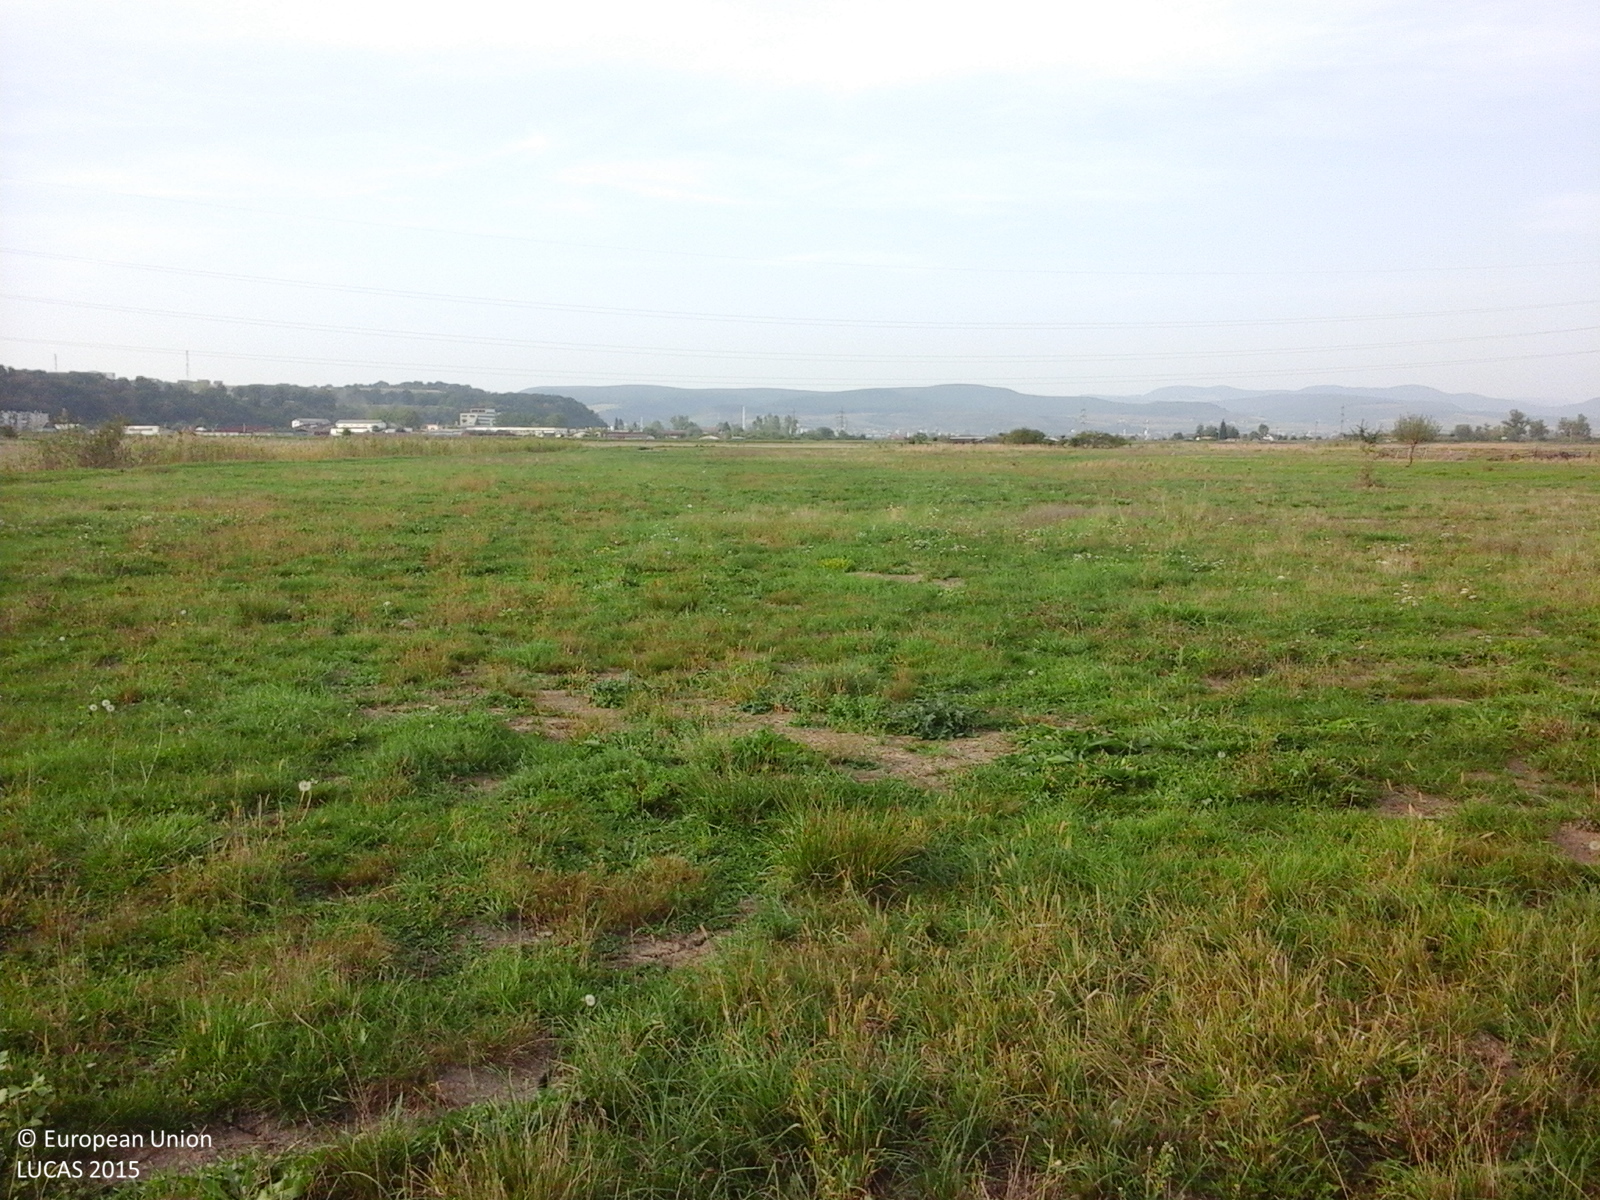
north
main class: Grassland
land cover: Grassland without tree/shrub cover
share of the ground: > 75 %
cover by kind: herbaceous plants 100 %
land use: Agriculture (excluding fallow land and kitchen gardens)
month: September
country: RO
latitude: 47.1178
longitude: 23.9050
